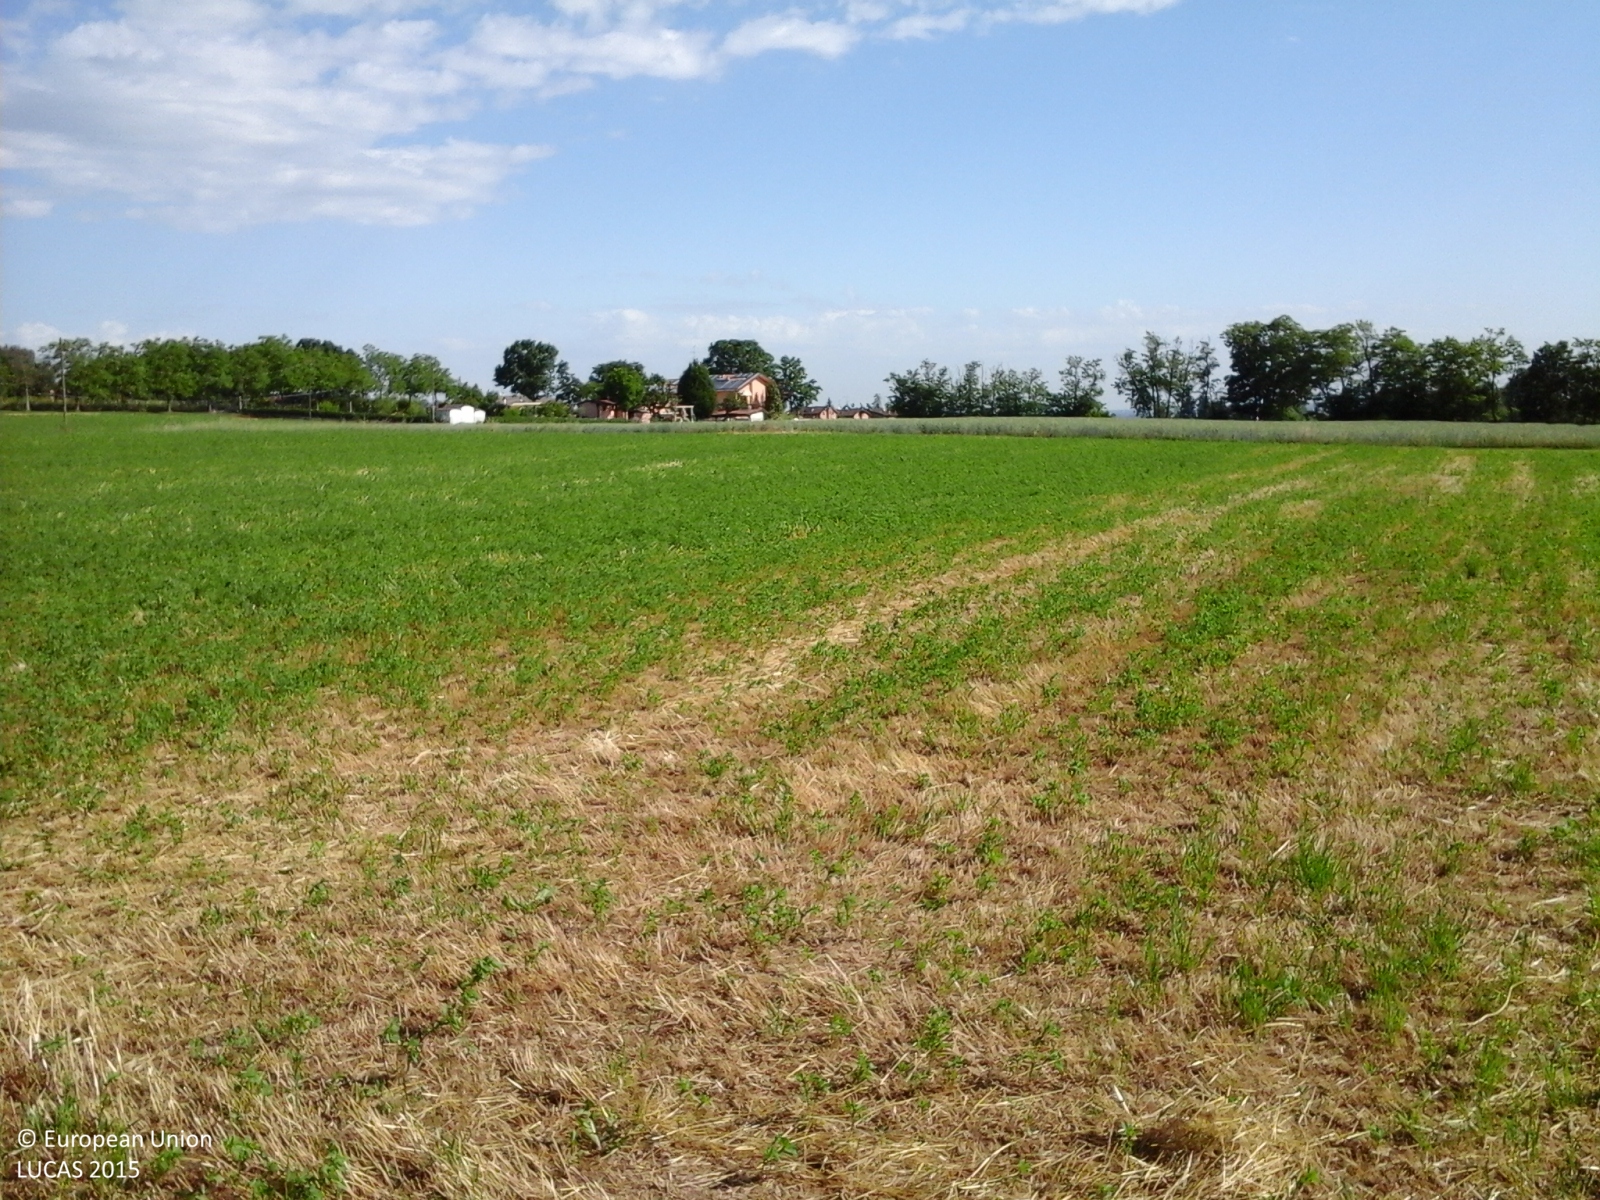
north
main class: Cropland
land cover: Lucerne
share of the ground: > 75 %
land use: Agriculture (excluding fallow land and kitchen gardens)
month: May
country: IT
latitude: 44.6011
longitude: 10.6411
